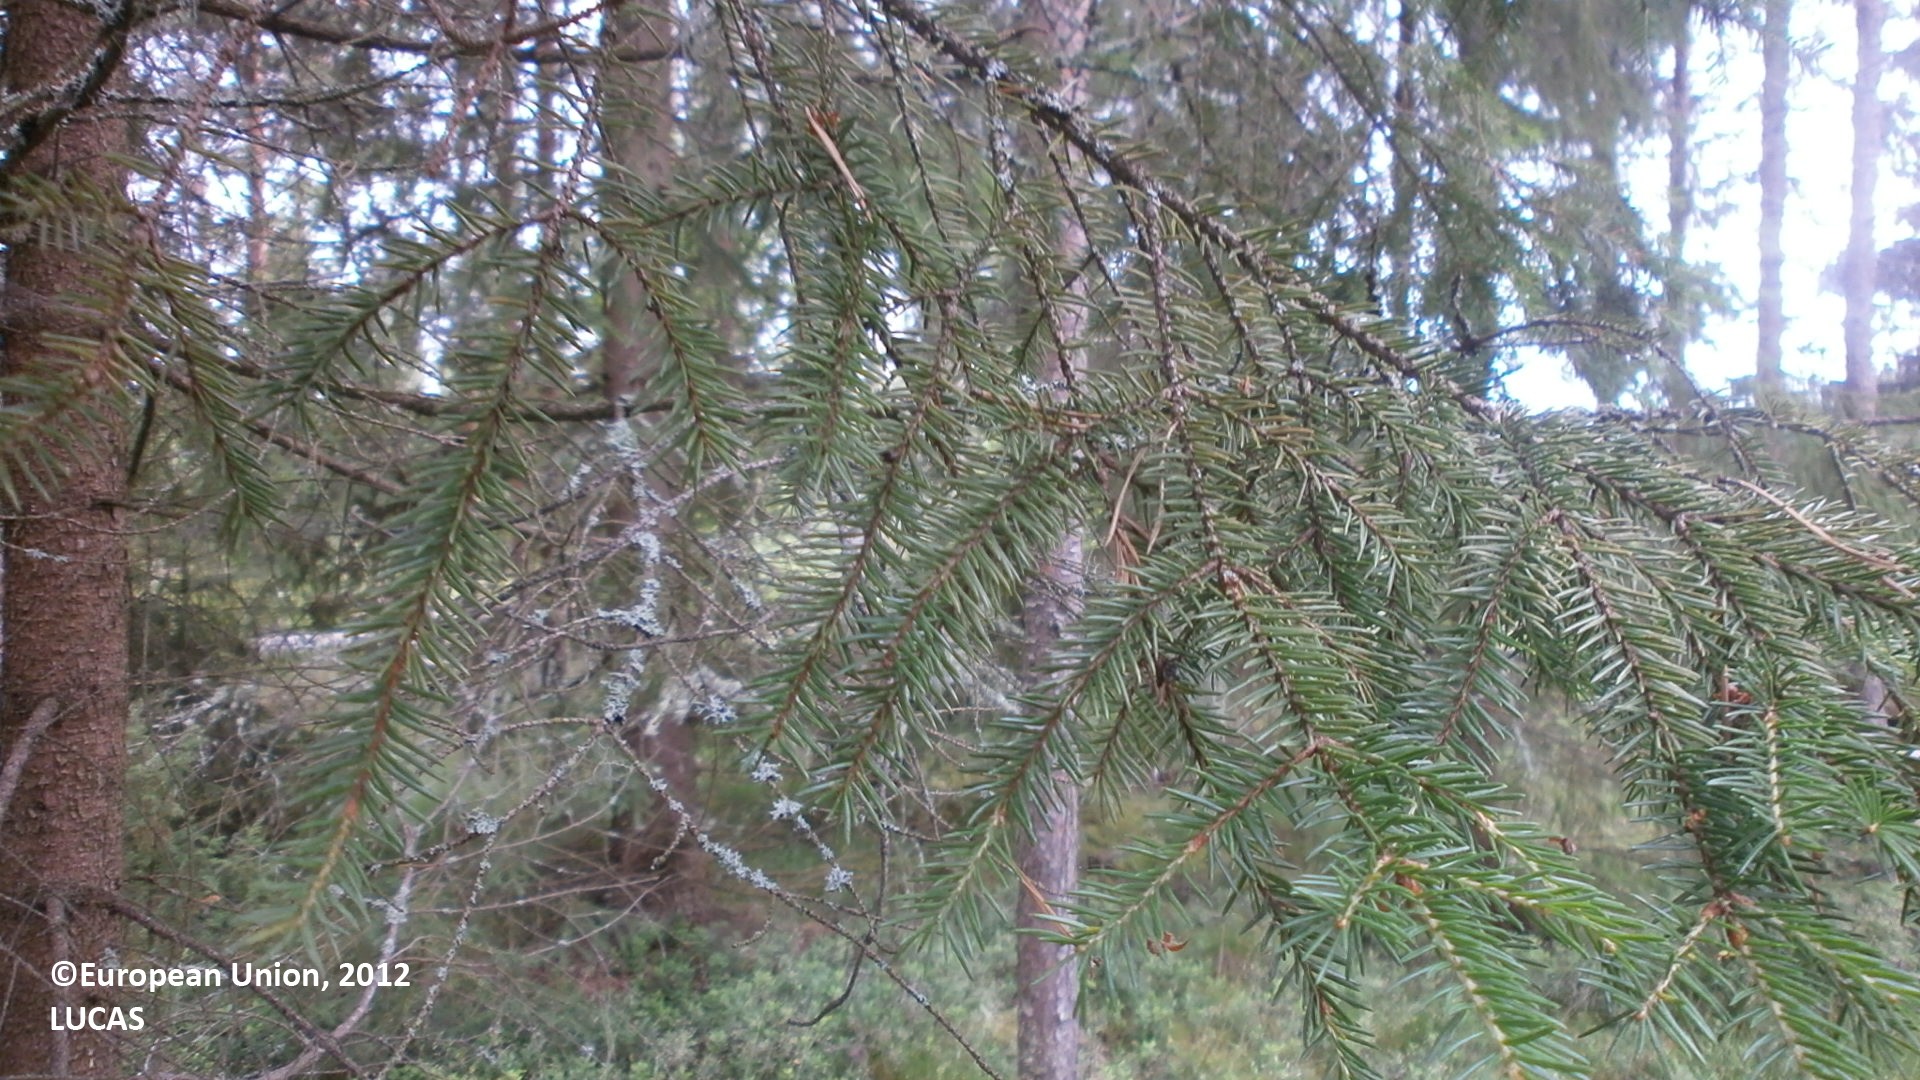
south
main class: Woodland
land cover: Pine dominated coniferous woodland
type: boreal forest
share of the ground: 50 - 75 %
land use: Forestry
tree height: > 5 m
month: July
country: FI
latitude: 64.3435
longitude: 24.4145
